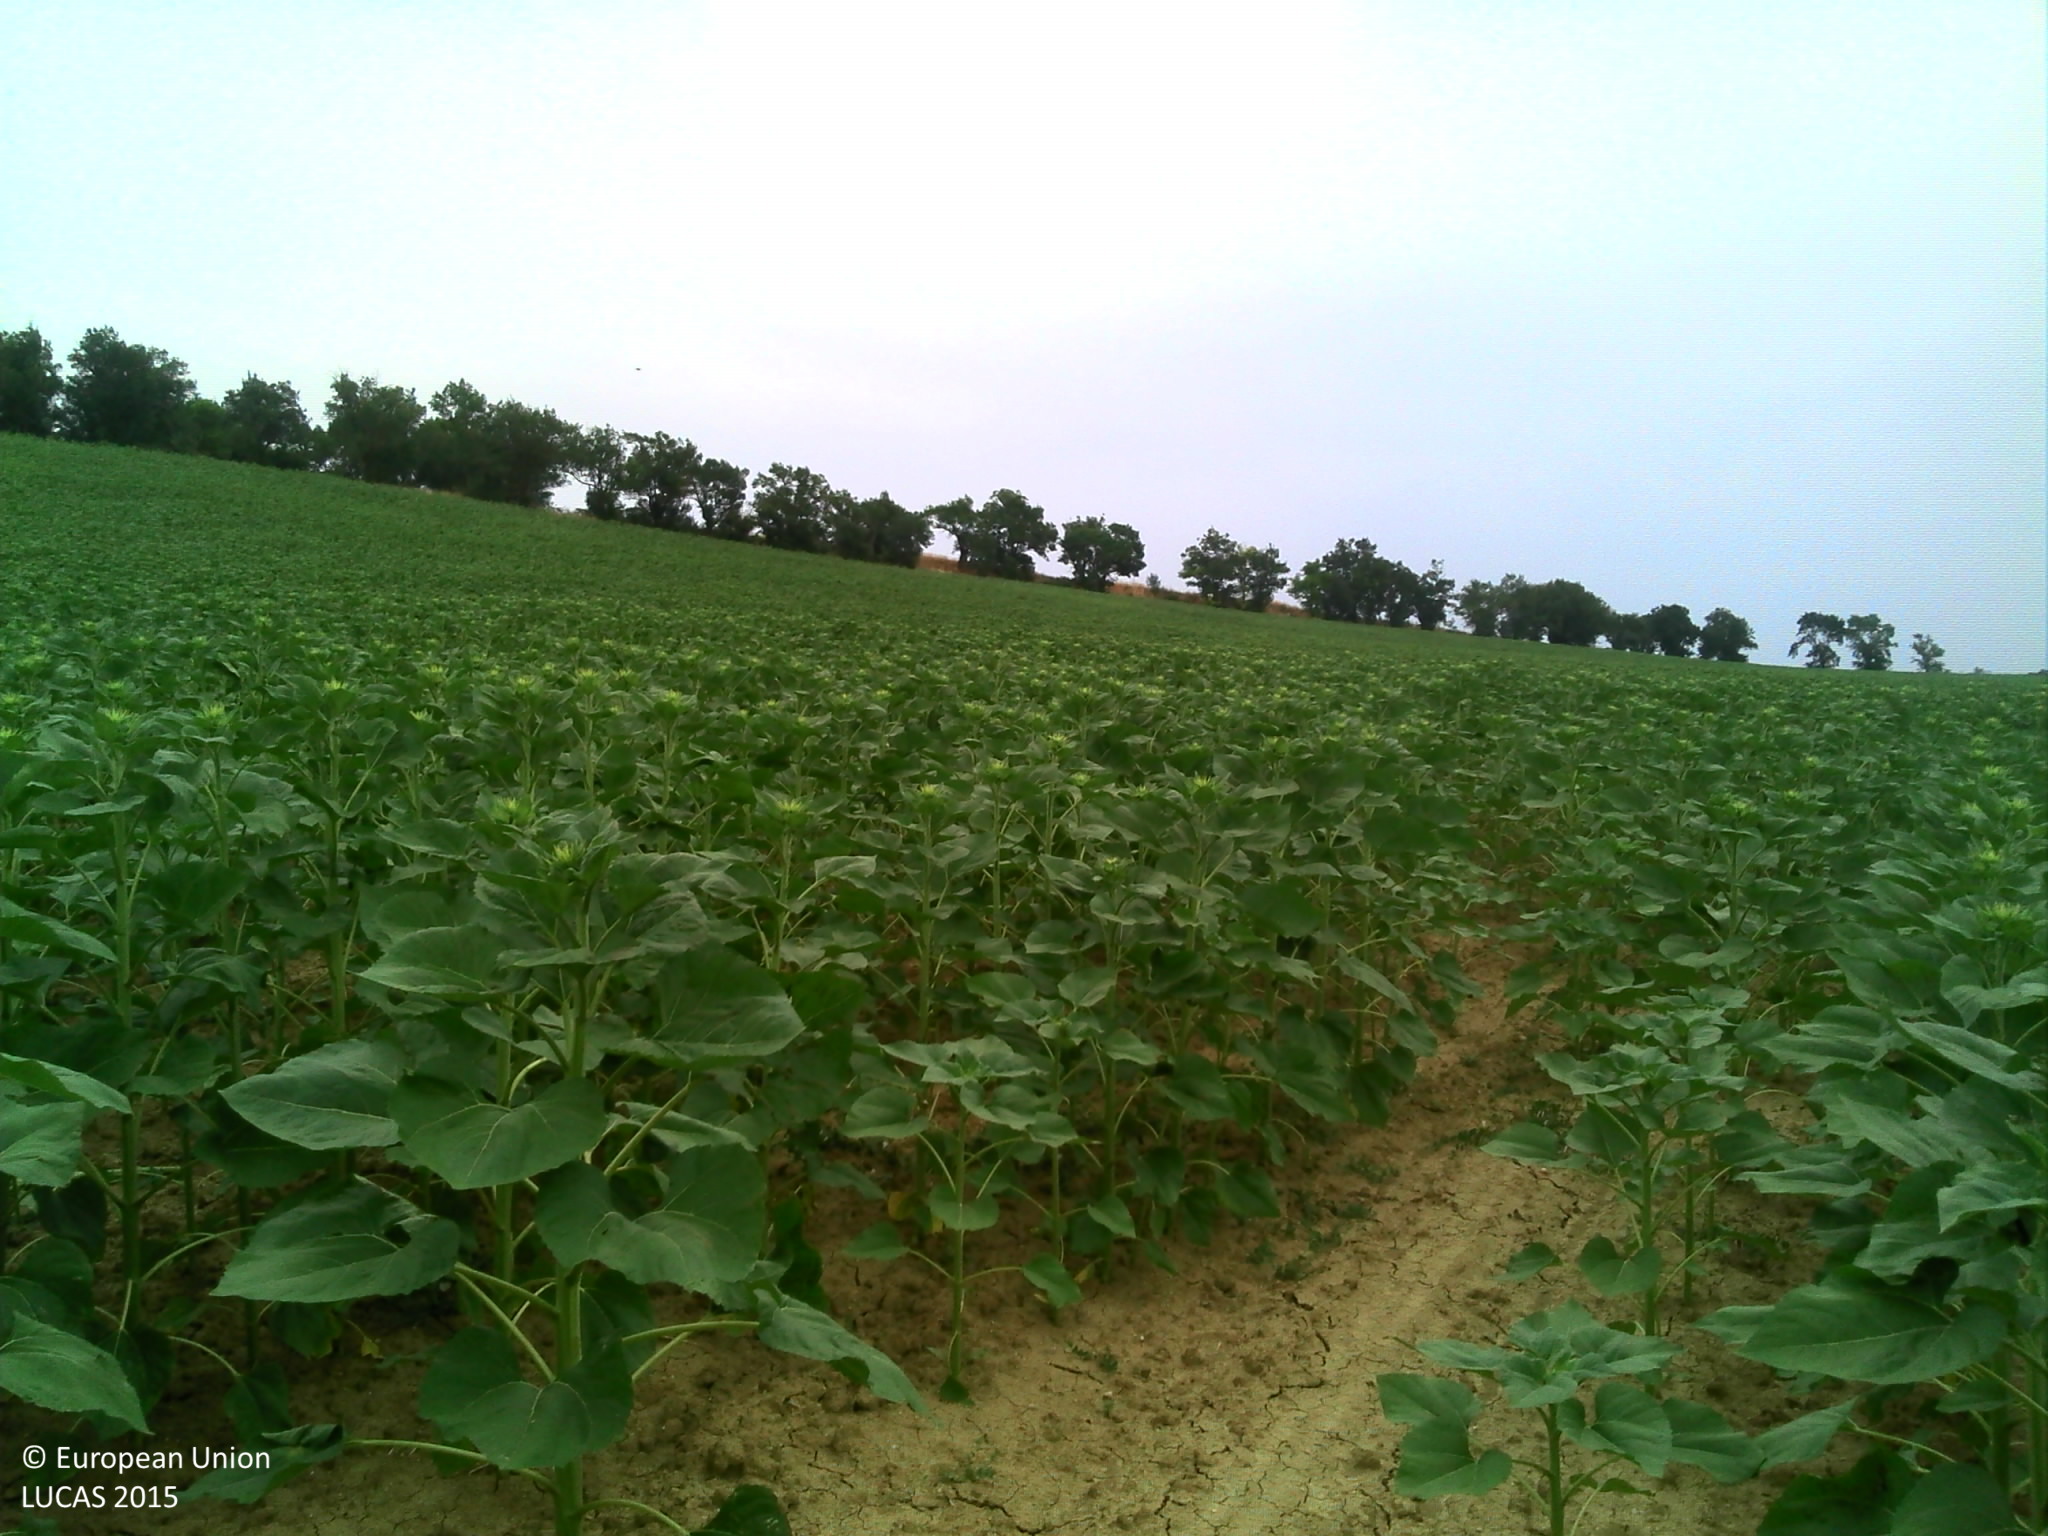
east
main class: Cropland
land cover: Sunflower
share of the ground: > 75 %
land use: Agriculture (excluding fallow land and kitchen gardens)
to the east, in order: Sunflower; Grass margins; Lines of trees; Tracks; Grass margins; Lines of trees; Common wheat
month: July
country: FR
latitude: 43.4785
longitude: 1.7584
